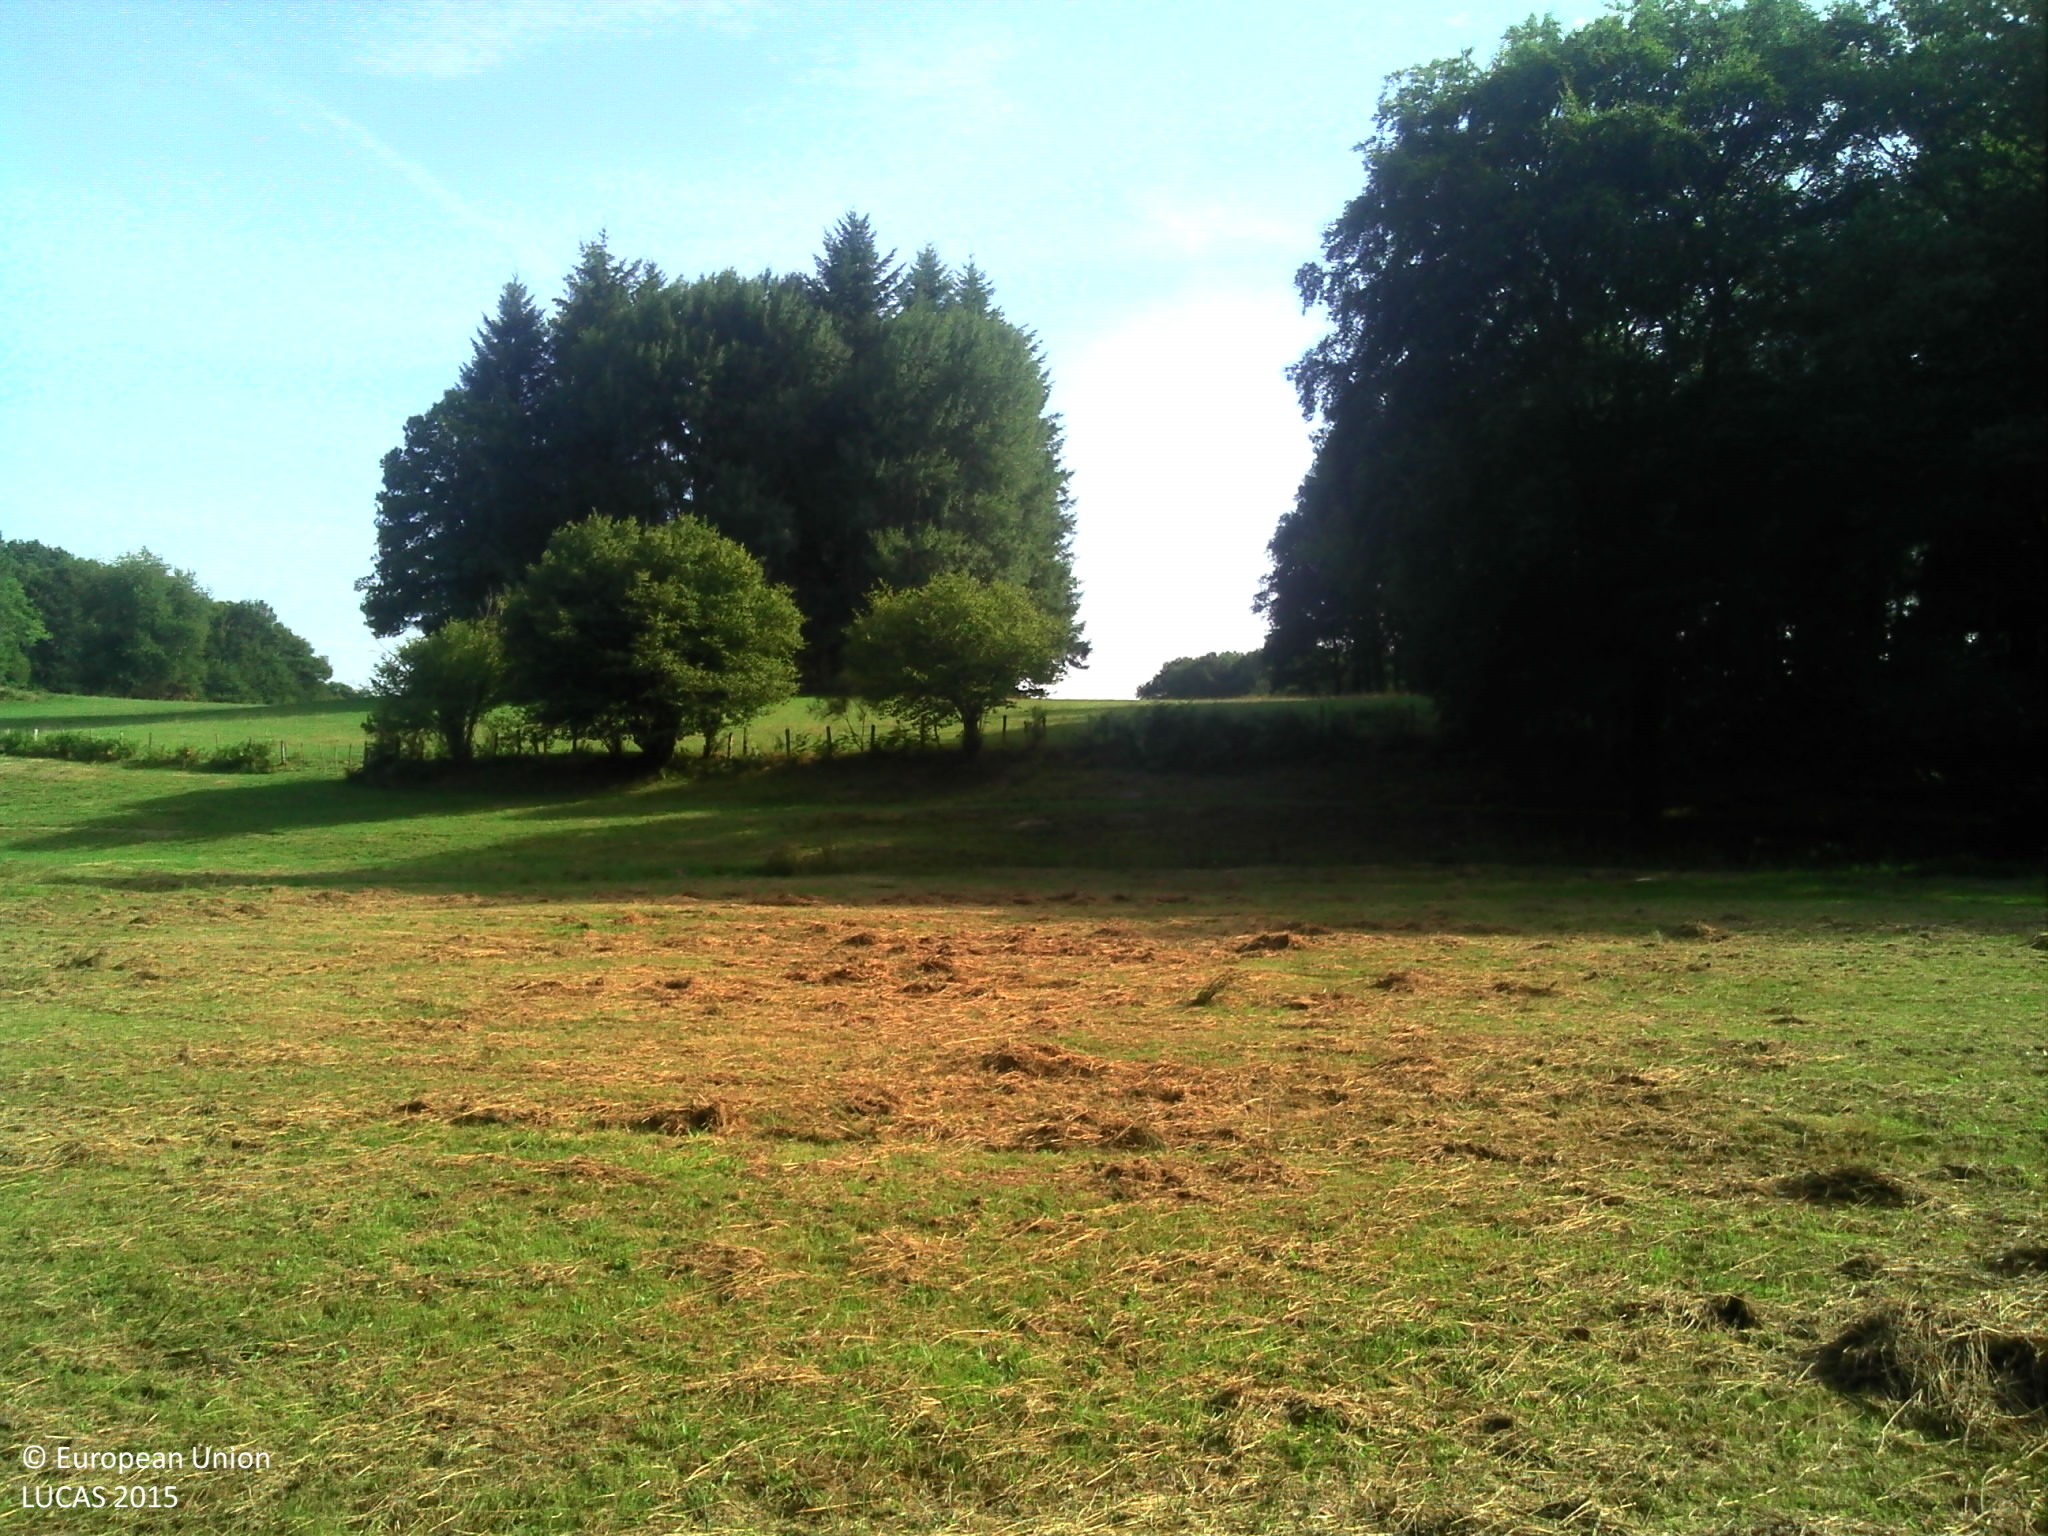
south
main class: Woodland
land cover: Broadleaved woodland
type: floodplain forest
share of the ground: > 75 %
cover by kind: broadleaved forest trees 70 %, shrubs 15 %, herbaceous plants 15 %
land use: Forestry
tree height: > 5 m
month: August
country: FR
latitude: 46.1782
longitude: 1.7666
